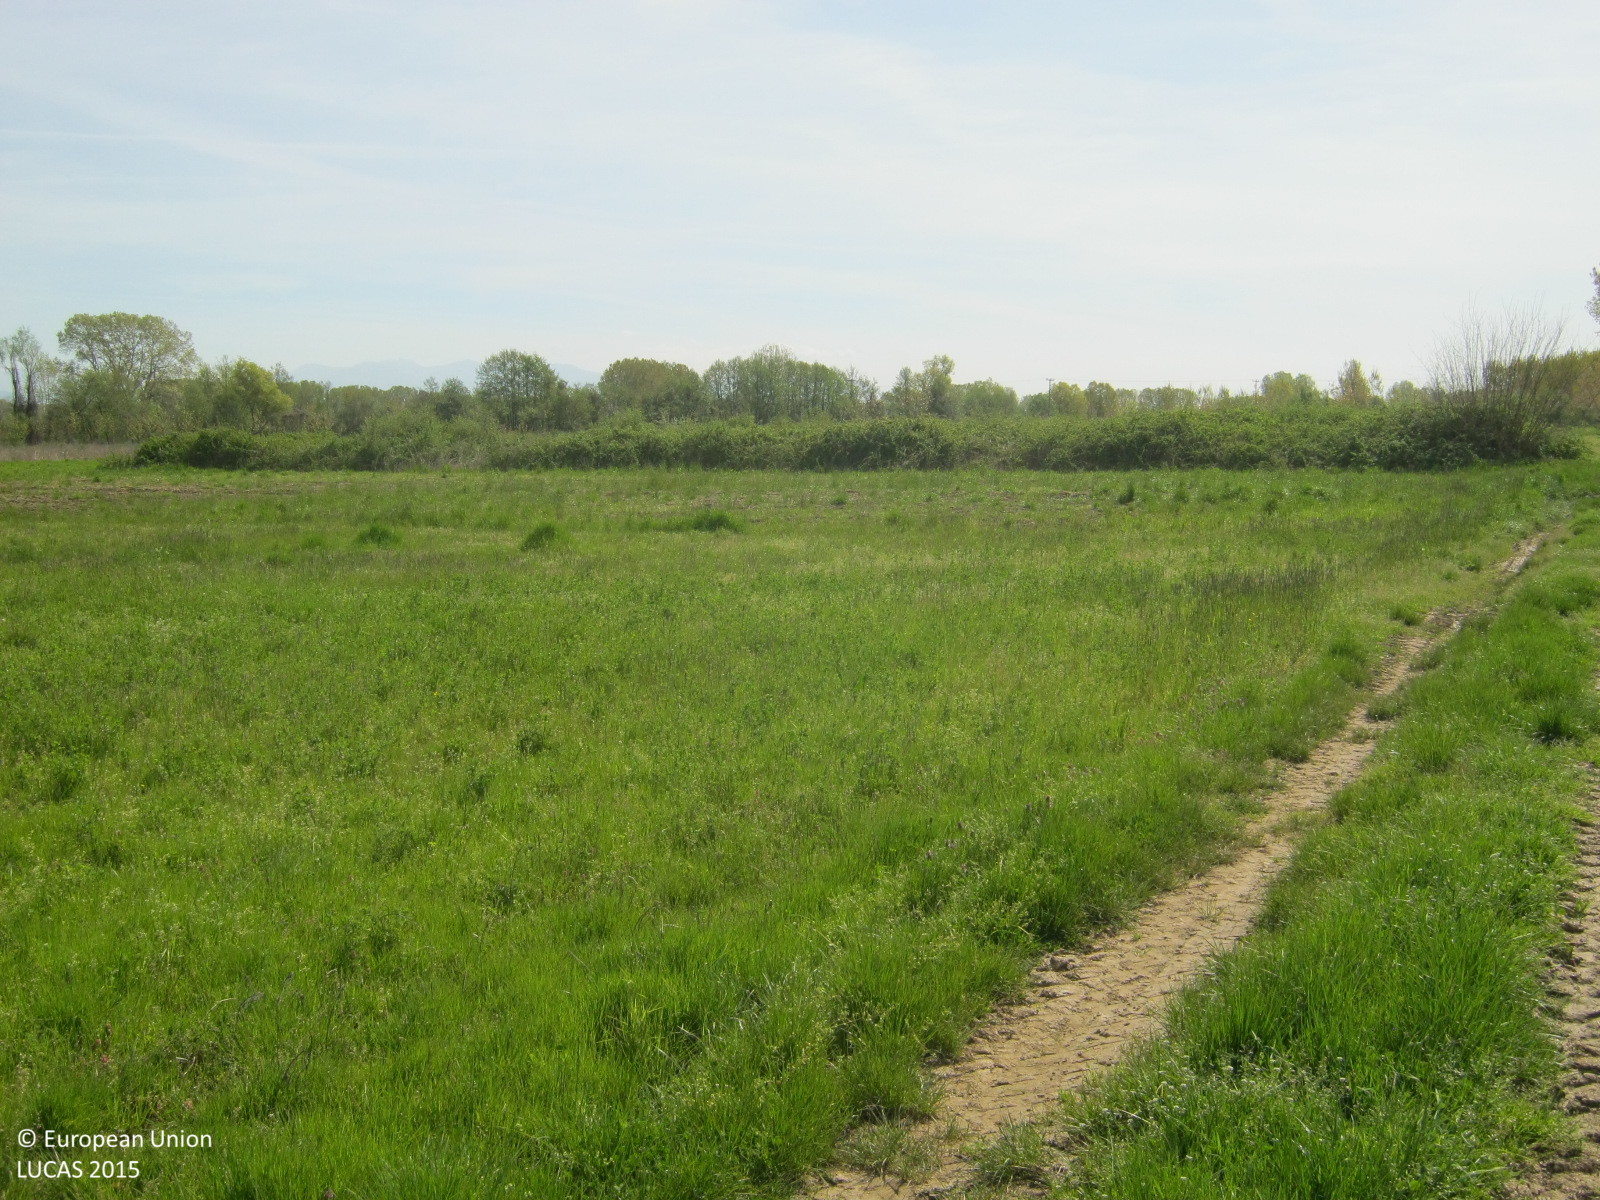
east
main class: Cropland
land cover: Barley
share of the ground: > 75 %
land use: Agriculture (excluding fallow land and kitchen gardens)
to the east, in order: Barley; Spontaneously vegetated surfaces; Tracks; Spontaneously vegetated surfaces; Shrubland without tree cover; Spontaneously vegetated surfaces; Common wheat; Lucerne
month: April
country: GR
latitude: 41.2205
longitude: 23.0528
